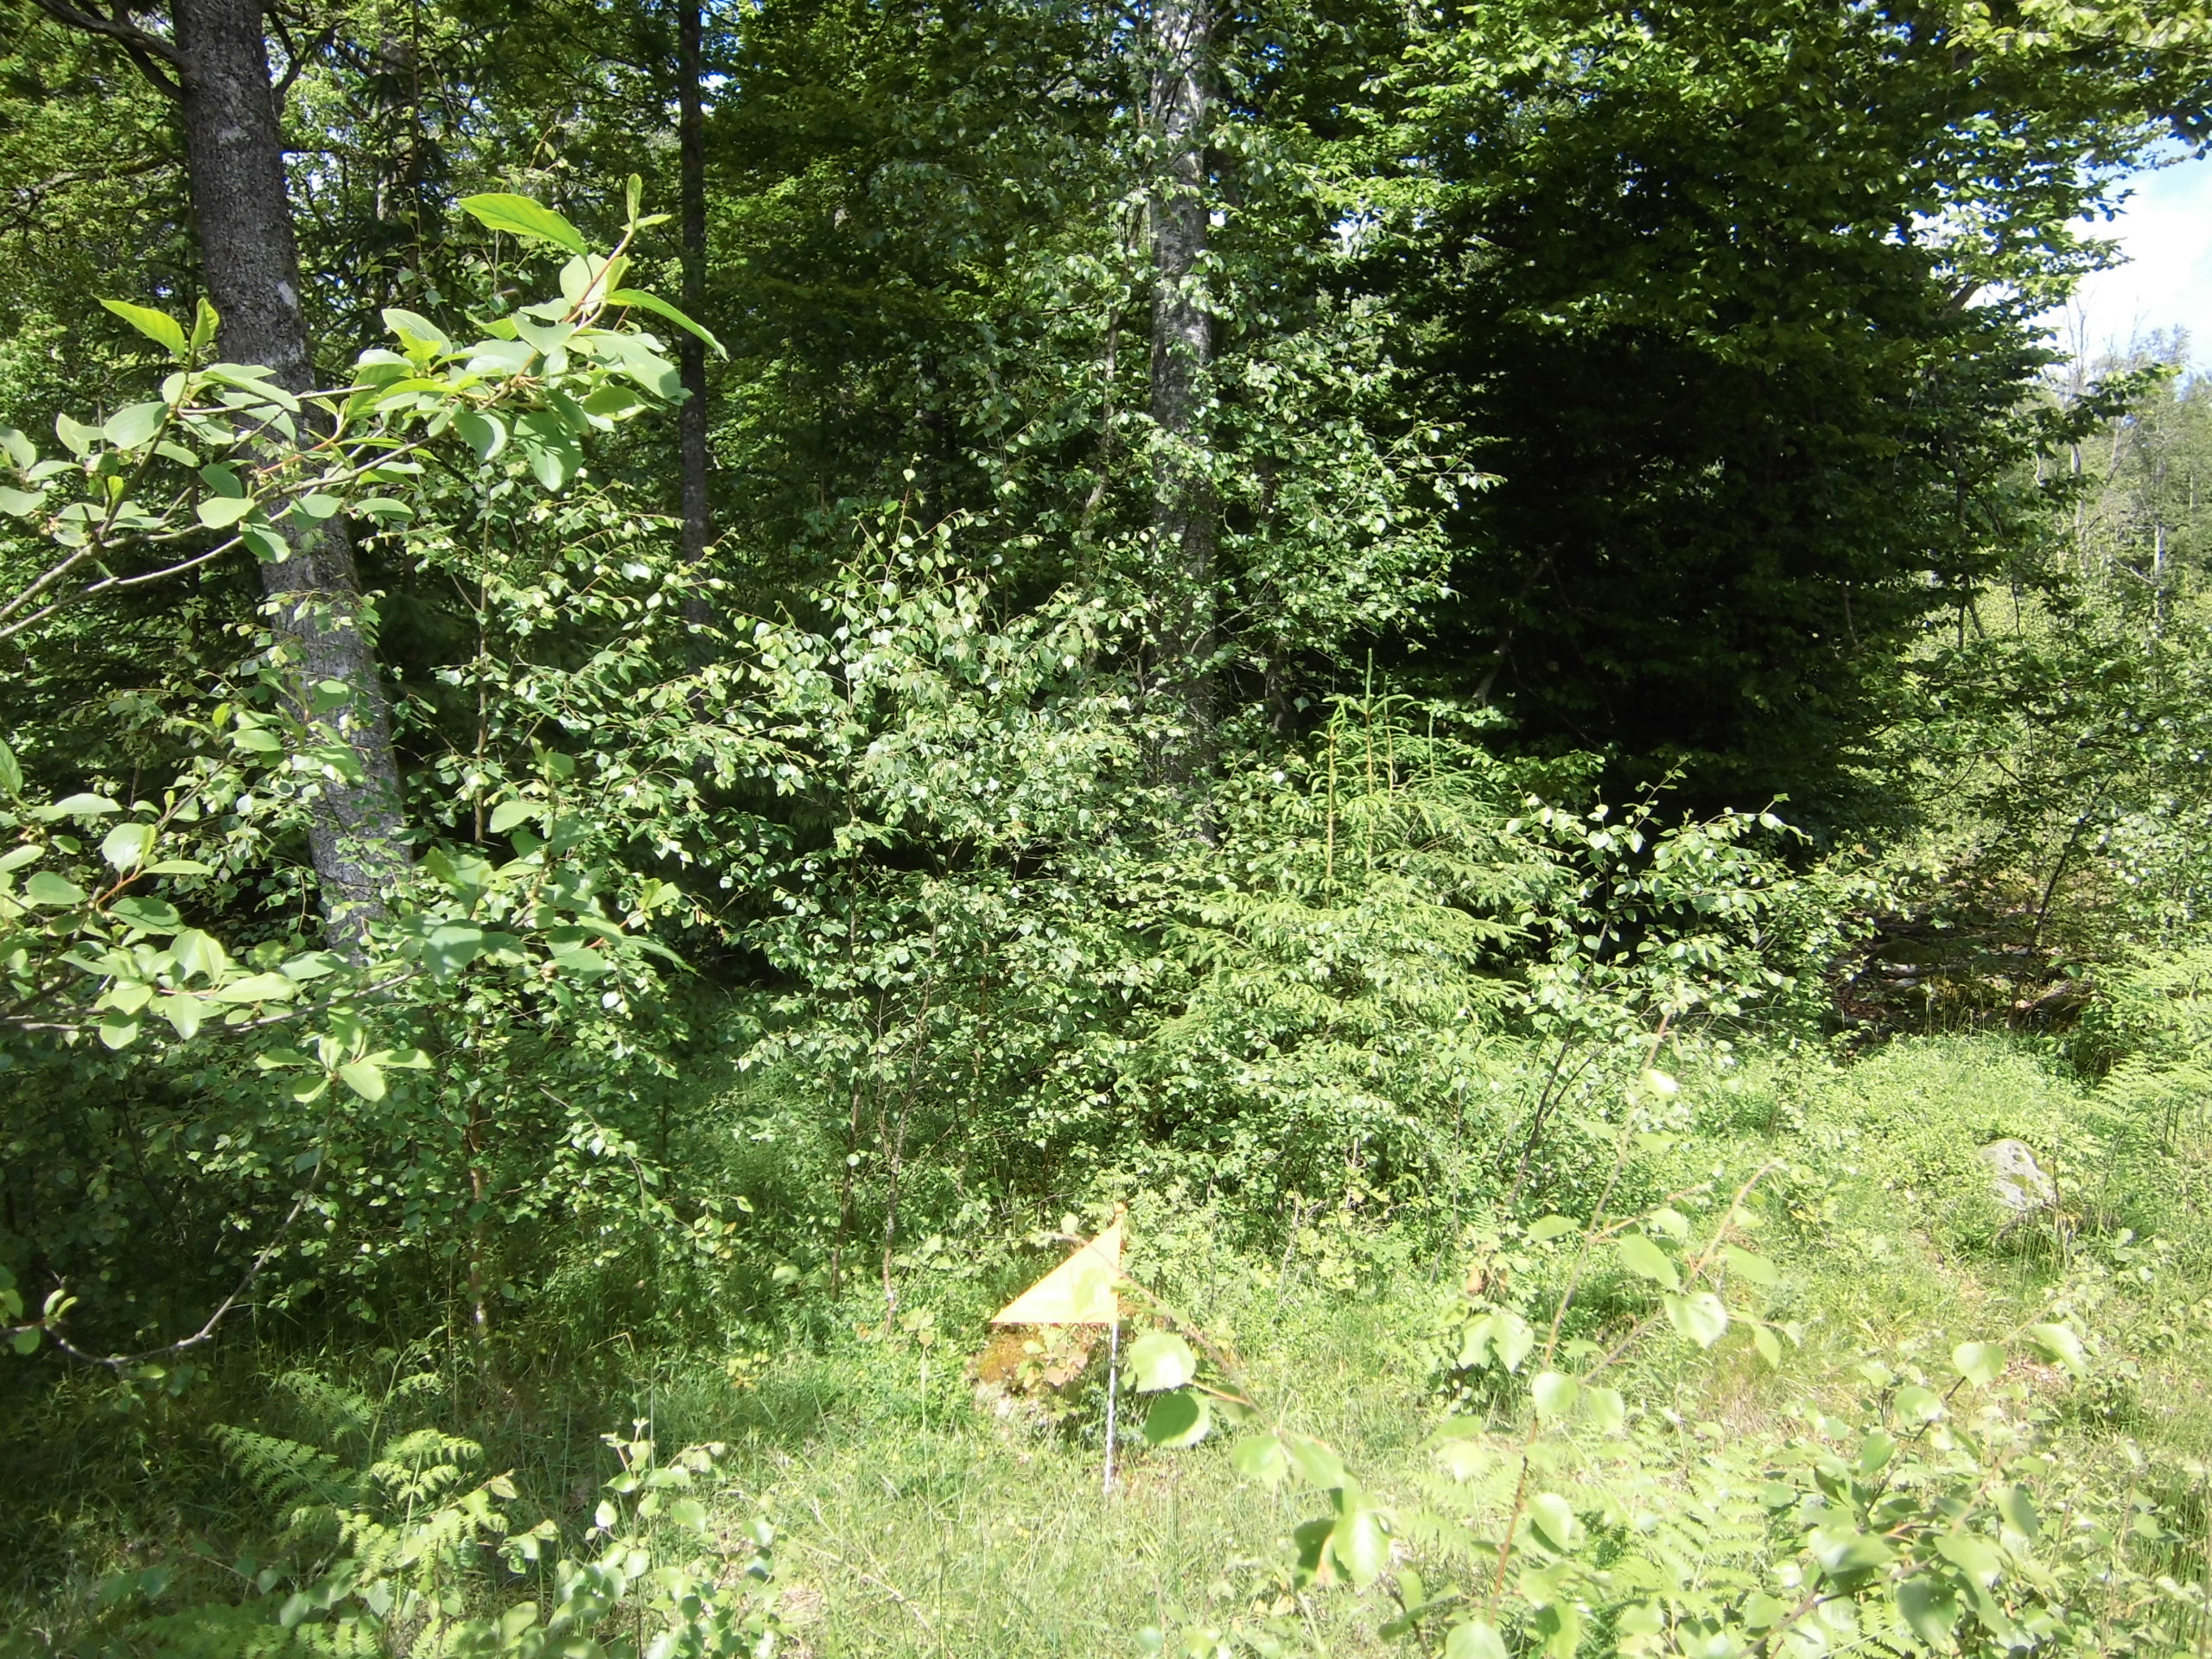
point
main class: Woodland
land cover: Broadleaved woodland
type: boreal forest
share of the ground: 50 - 75 %
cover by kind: broadleaved forest trees 55 %, herbaceous plants 20 %, coniferous forest trees 10 %, shrubs 10 %, lichens and mosses 5 %
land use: Forestry
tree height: > 5 m
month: June
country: SE
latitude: 56.9824
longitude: 14.7523
